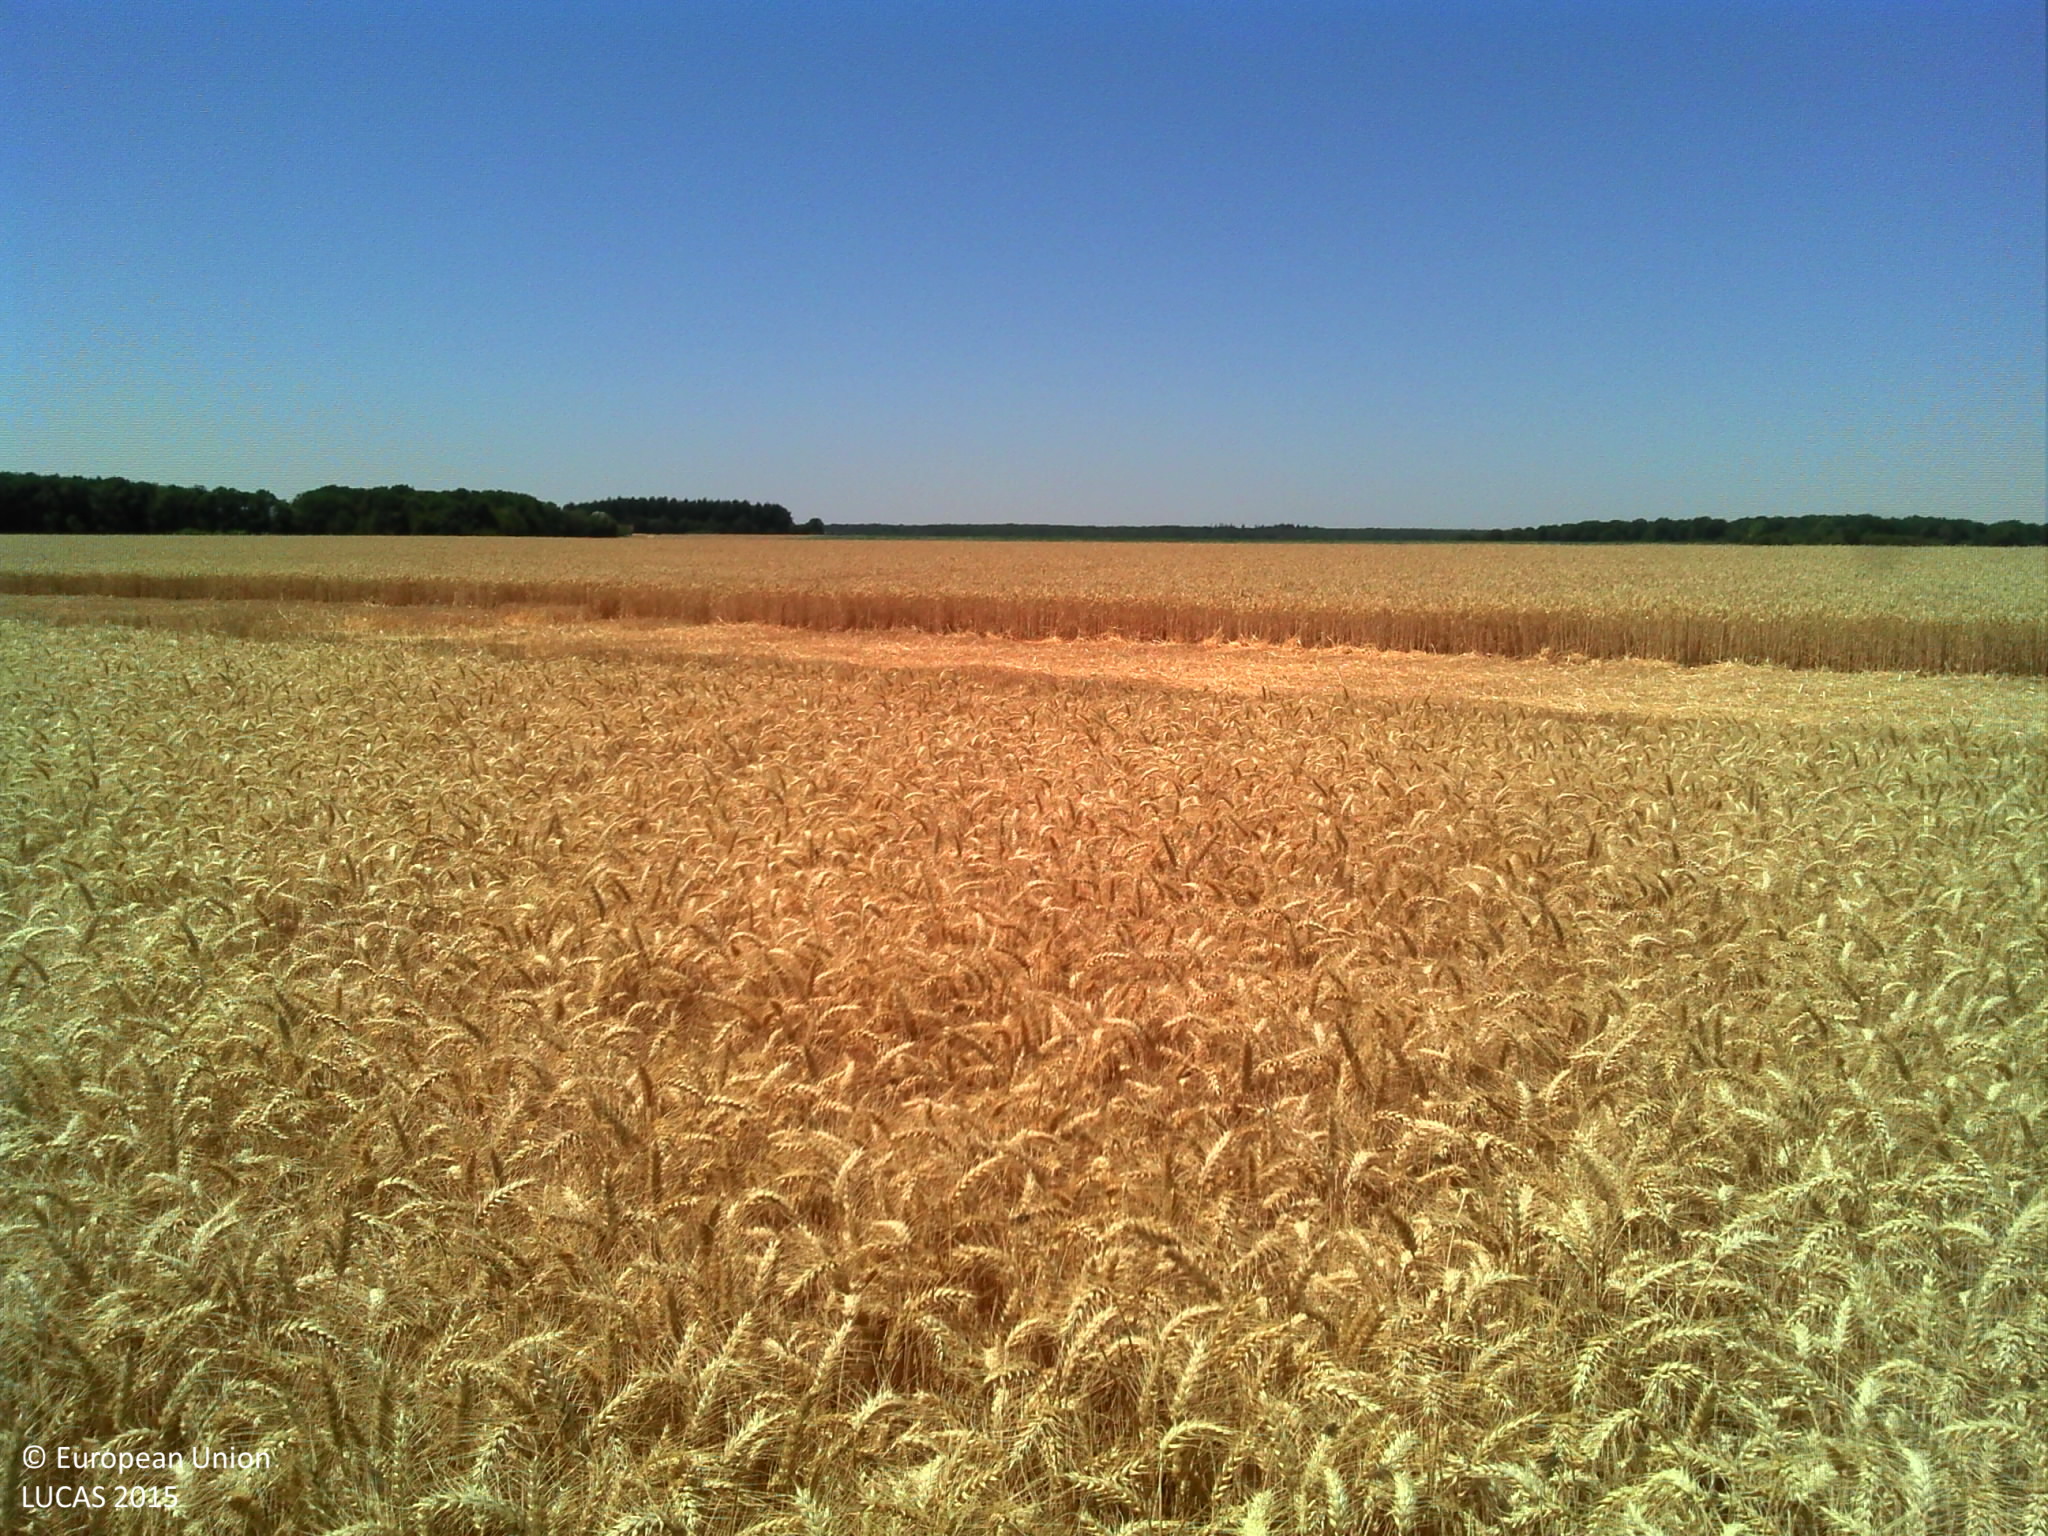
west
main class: Cropland
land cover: Common wheat
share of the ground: > 75 %
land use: Agriculture (excluding fallow land and kitchen gardens)
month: July
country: FR
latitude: 48.0423
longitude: 1.3044
